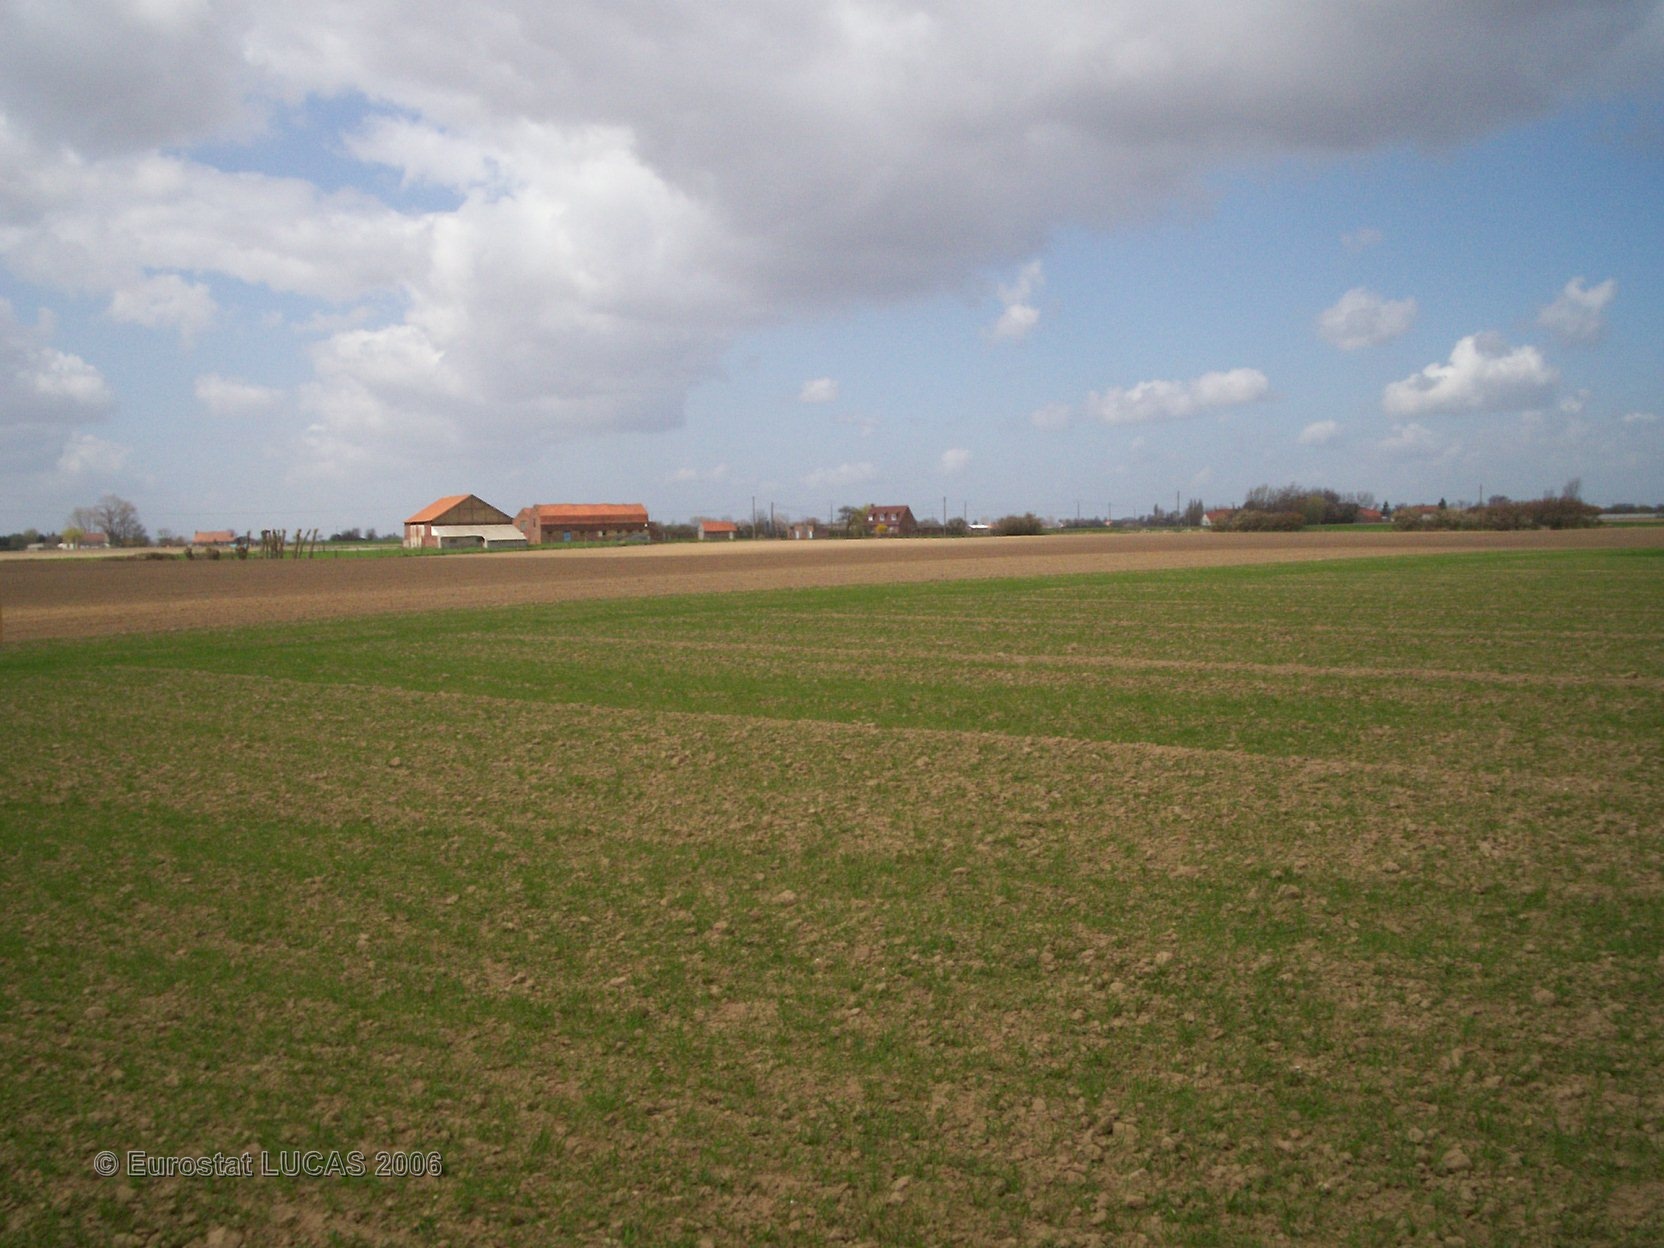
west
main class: Cropland
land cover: Common wheat
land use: Agriculture (excluding fallow land and kitchen gardens)
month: April
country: FR
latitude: 50.8581
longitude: 2.5005
